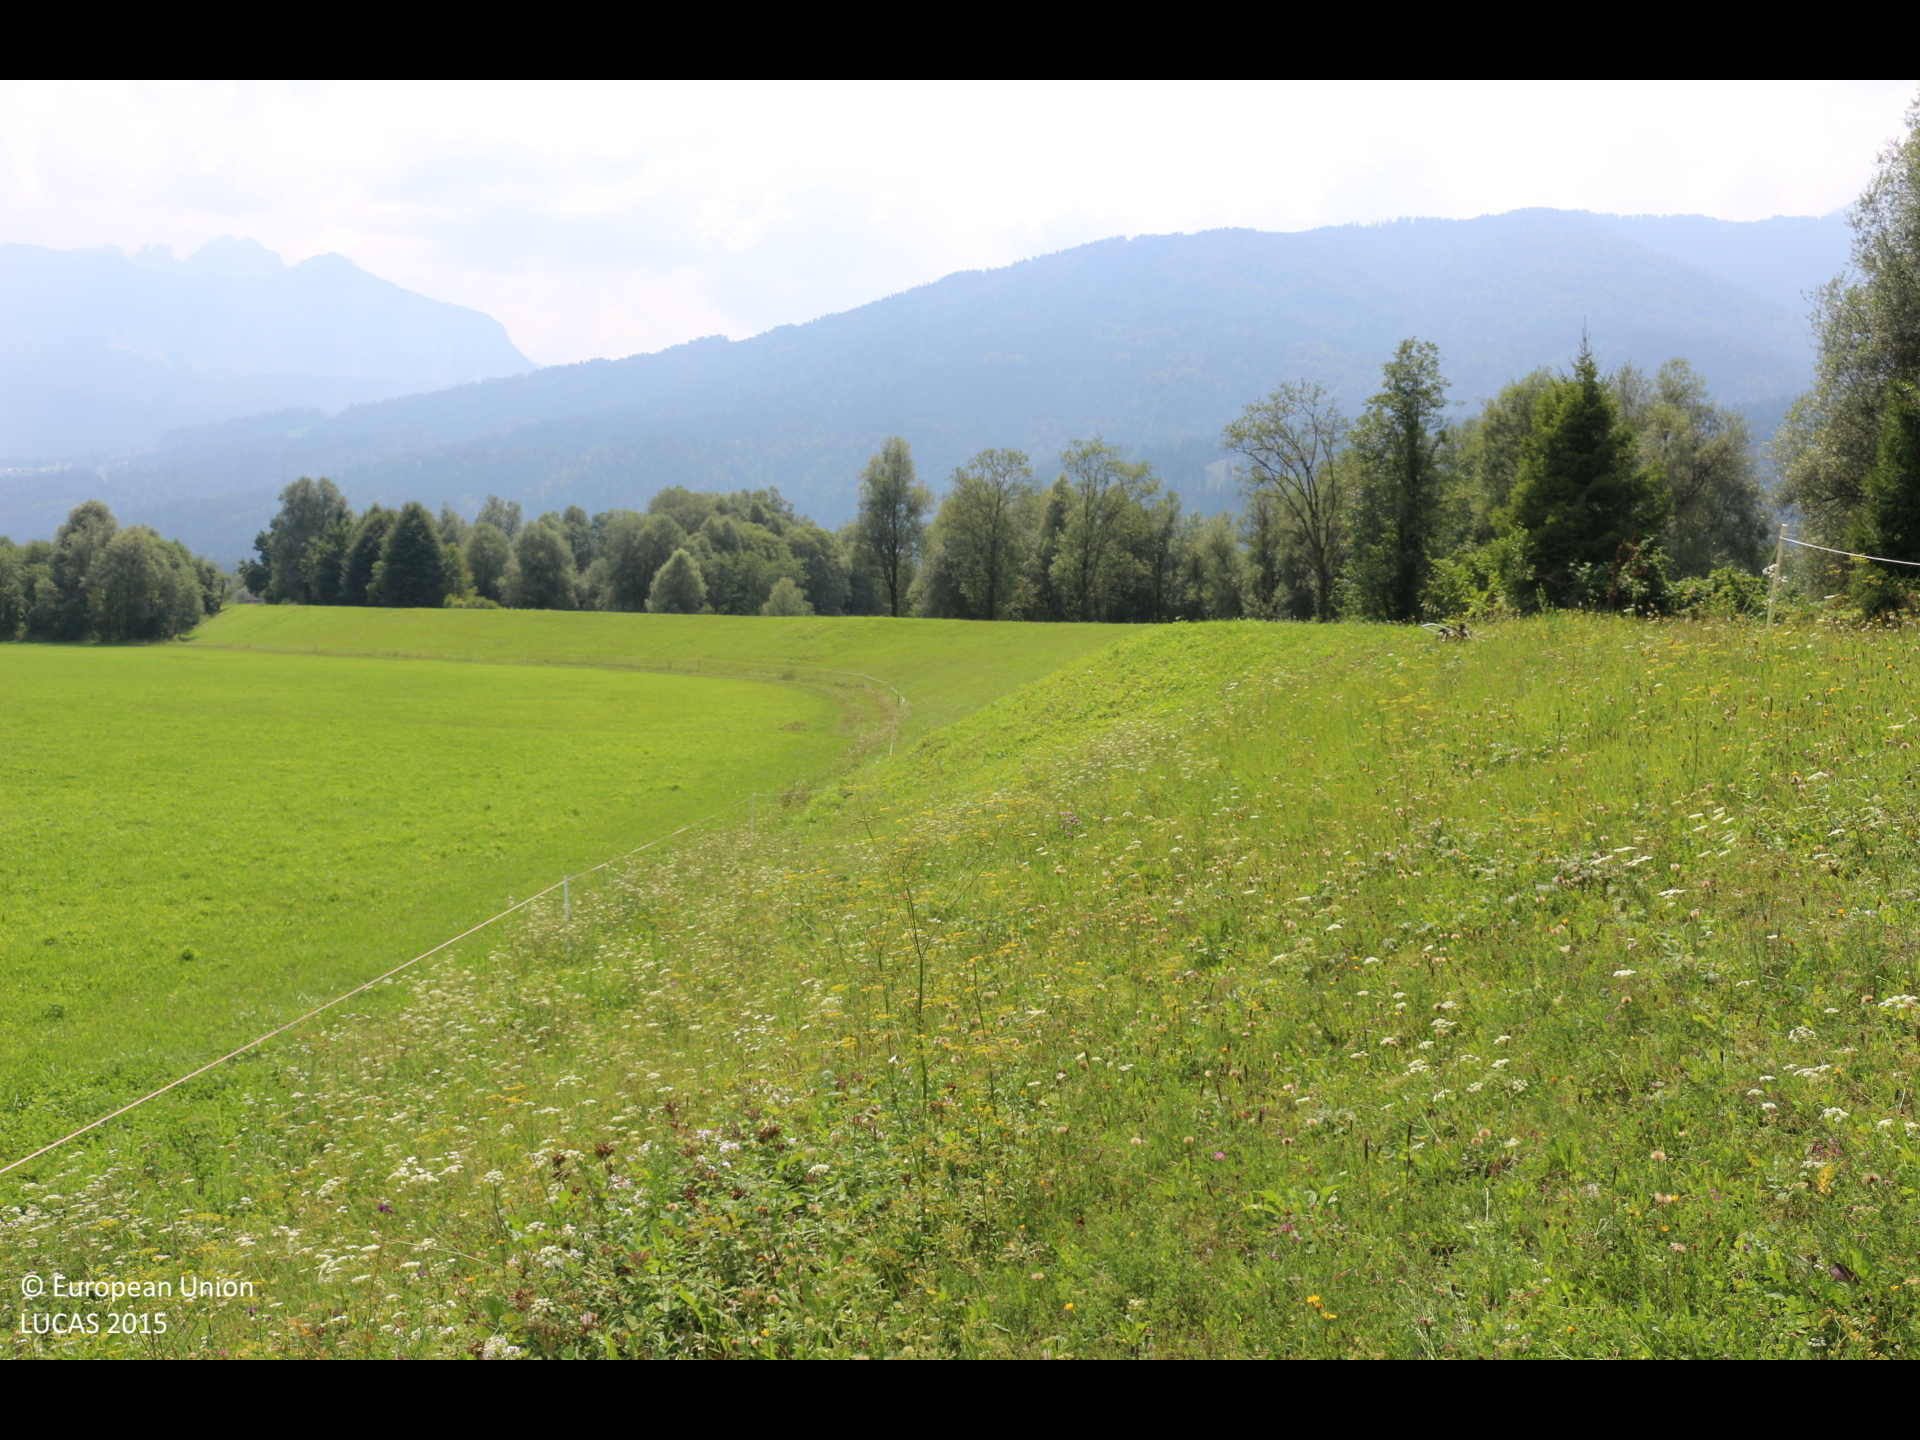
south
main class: Grassland
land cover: Grassland without tree/shrub cover
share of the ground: > 75 %
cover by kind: herbaceous plants 100 %
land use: Agriculture (excluding fallow land and kitchen gardens)
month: August
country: AT
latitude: 46.6263
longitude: 13.2492
